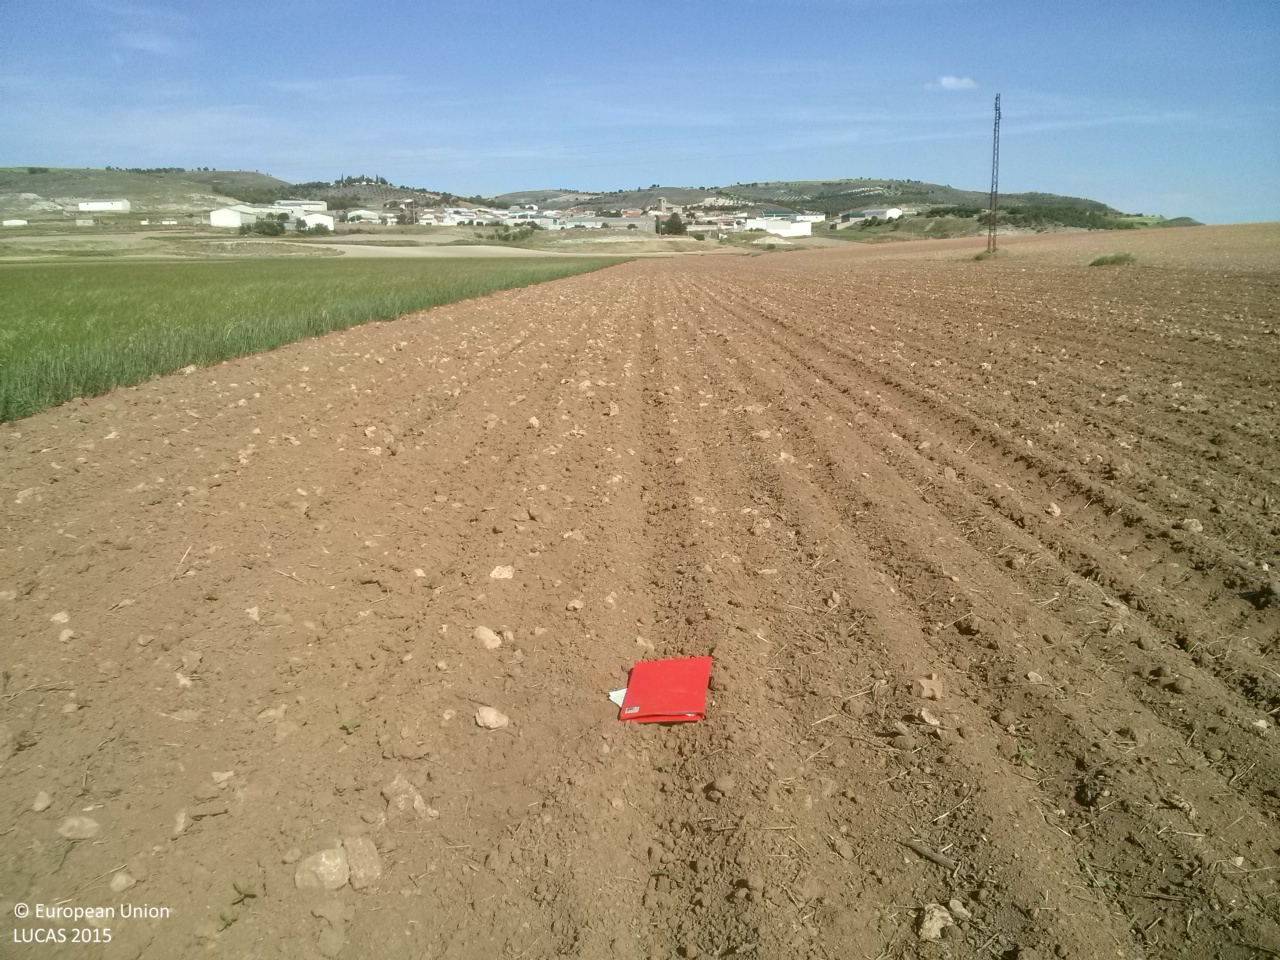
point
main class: Cropland
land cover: Sunflower
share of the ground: < 10 %
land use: Agriculture (excluding fallow land and kitchen gardens)
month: May
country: ES
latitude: 40.0758
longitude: -2.7210
